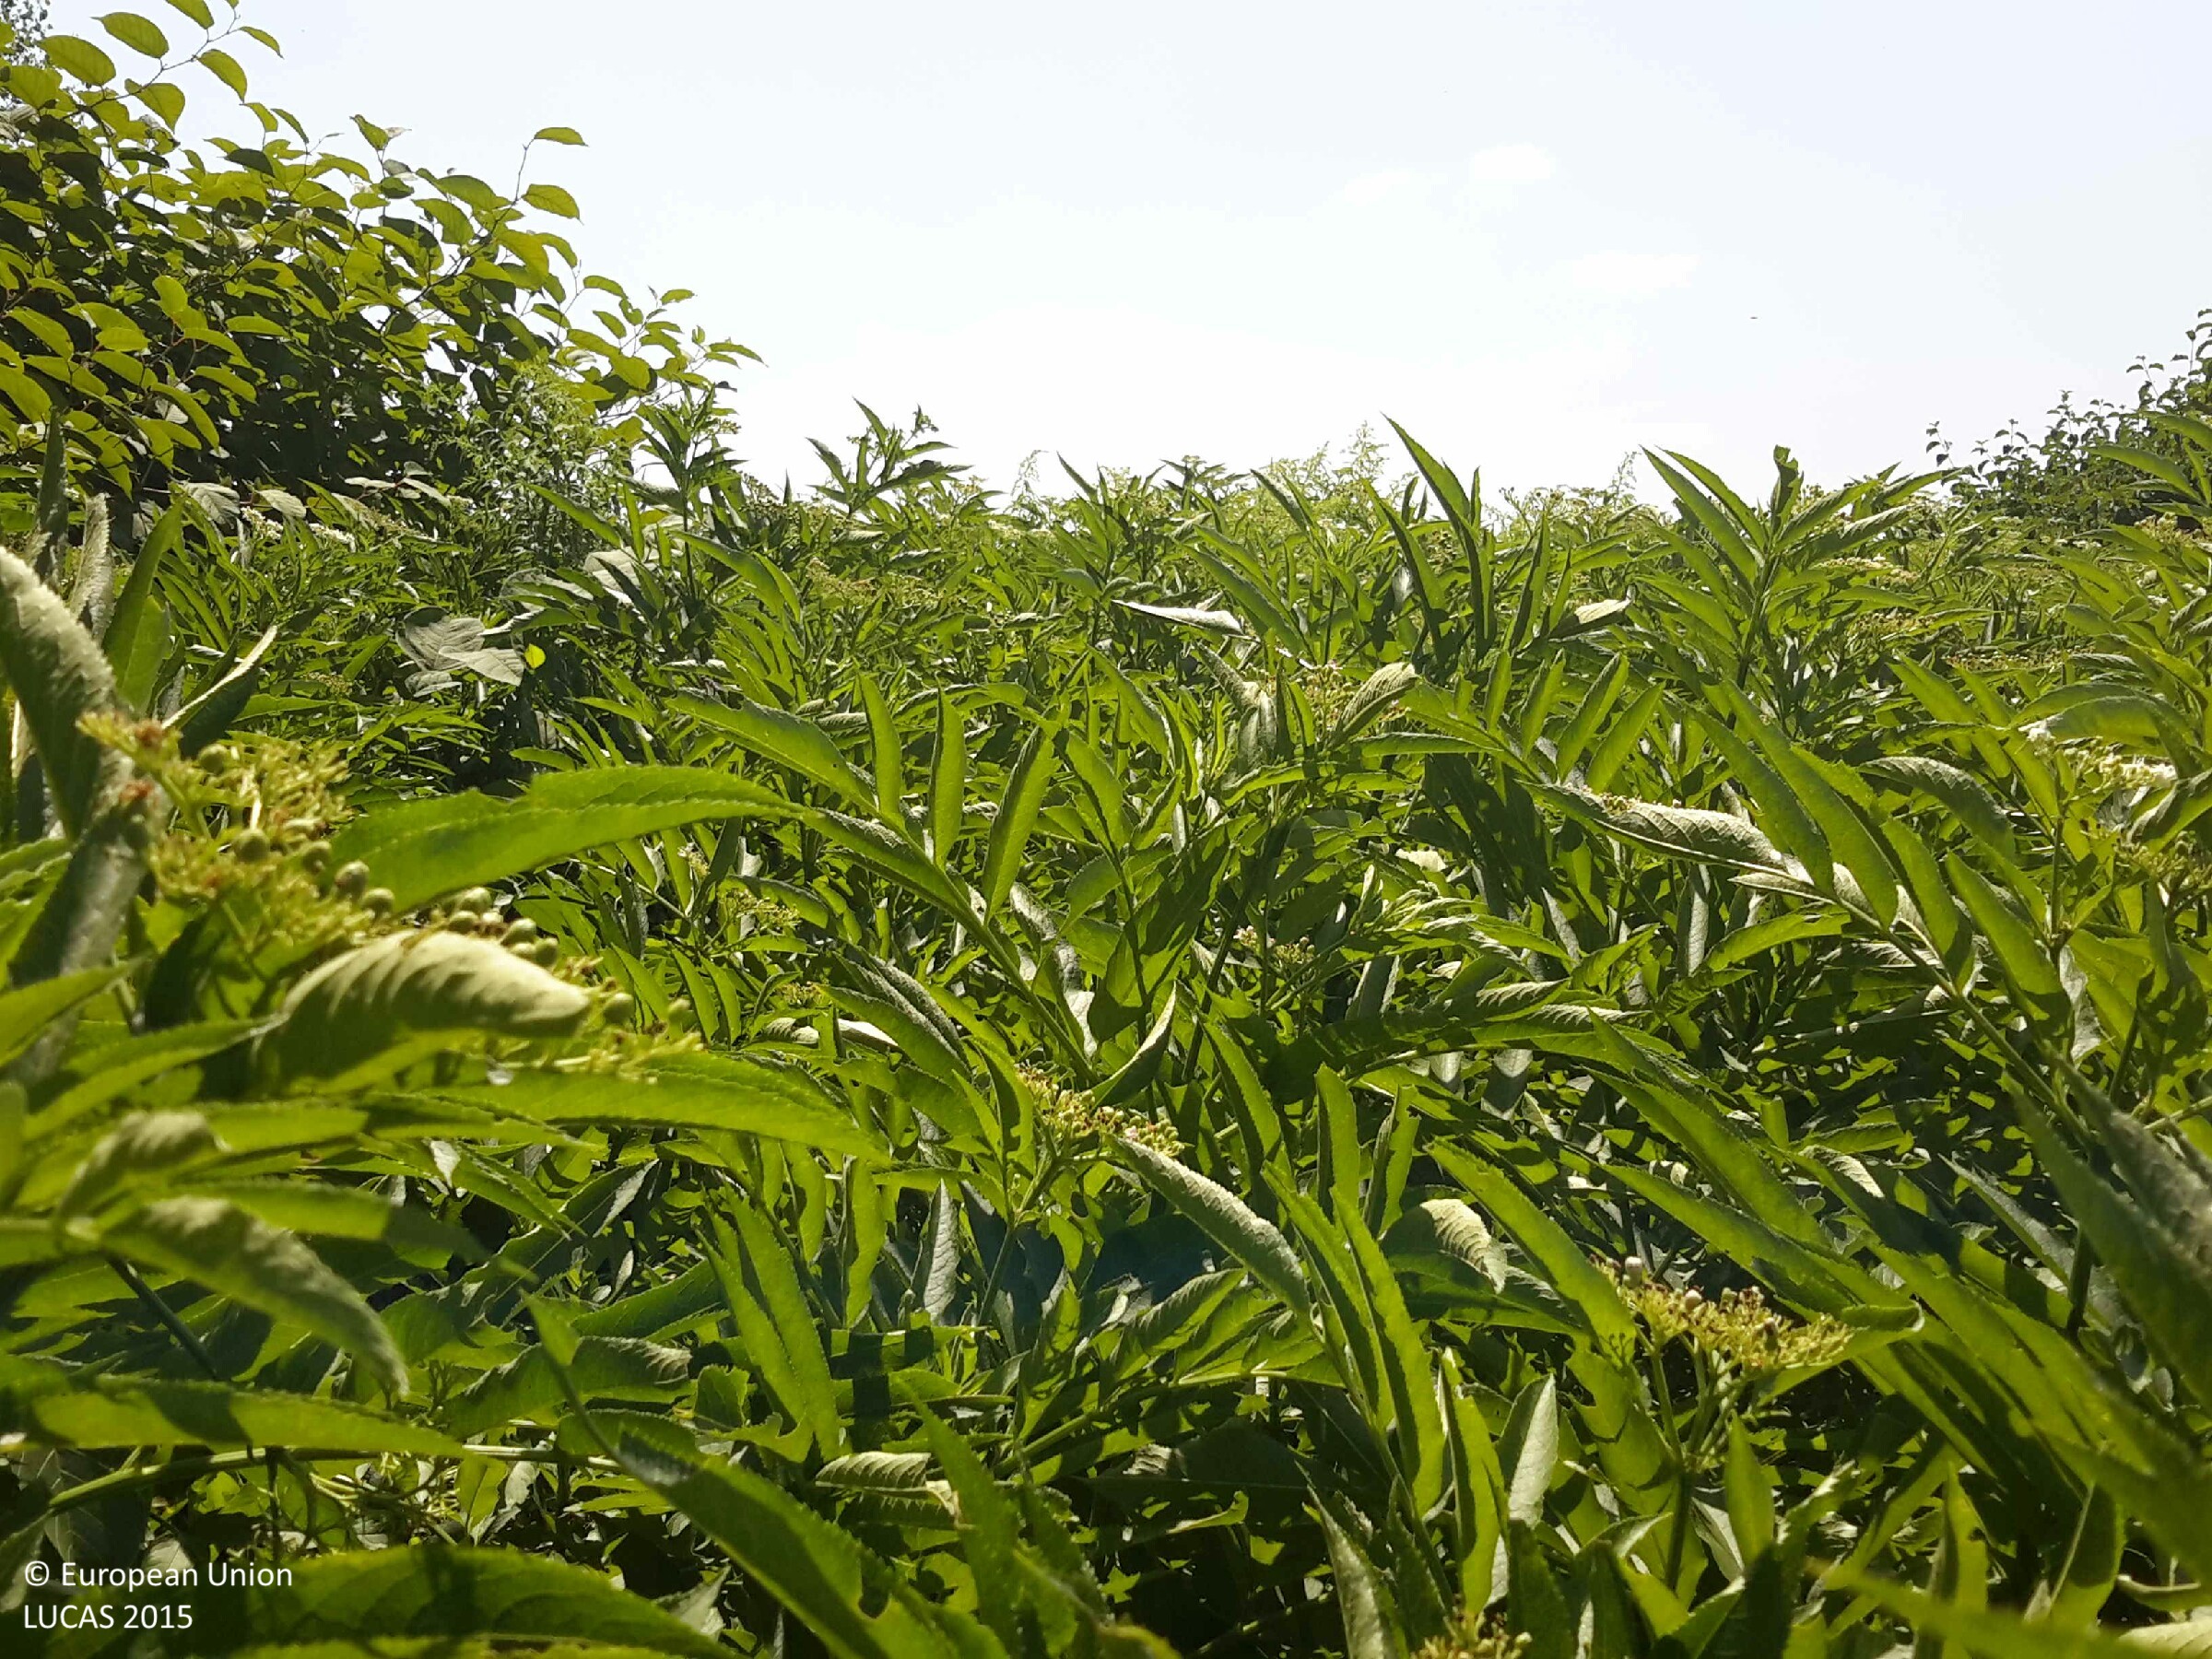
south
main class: Shrubland
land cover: Shrubland with sparse tree cover
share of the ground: 25 - 50 %
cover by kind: herbaceous plants 70 %, shrubs 25 %, broadleaved forest trees 5 %
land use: Semi-natural and natural areas not in use
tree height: > 5 m
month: July
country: HU
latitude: 47.4393
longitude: 17.8197
